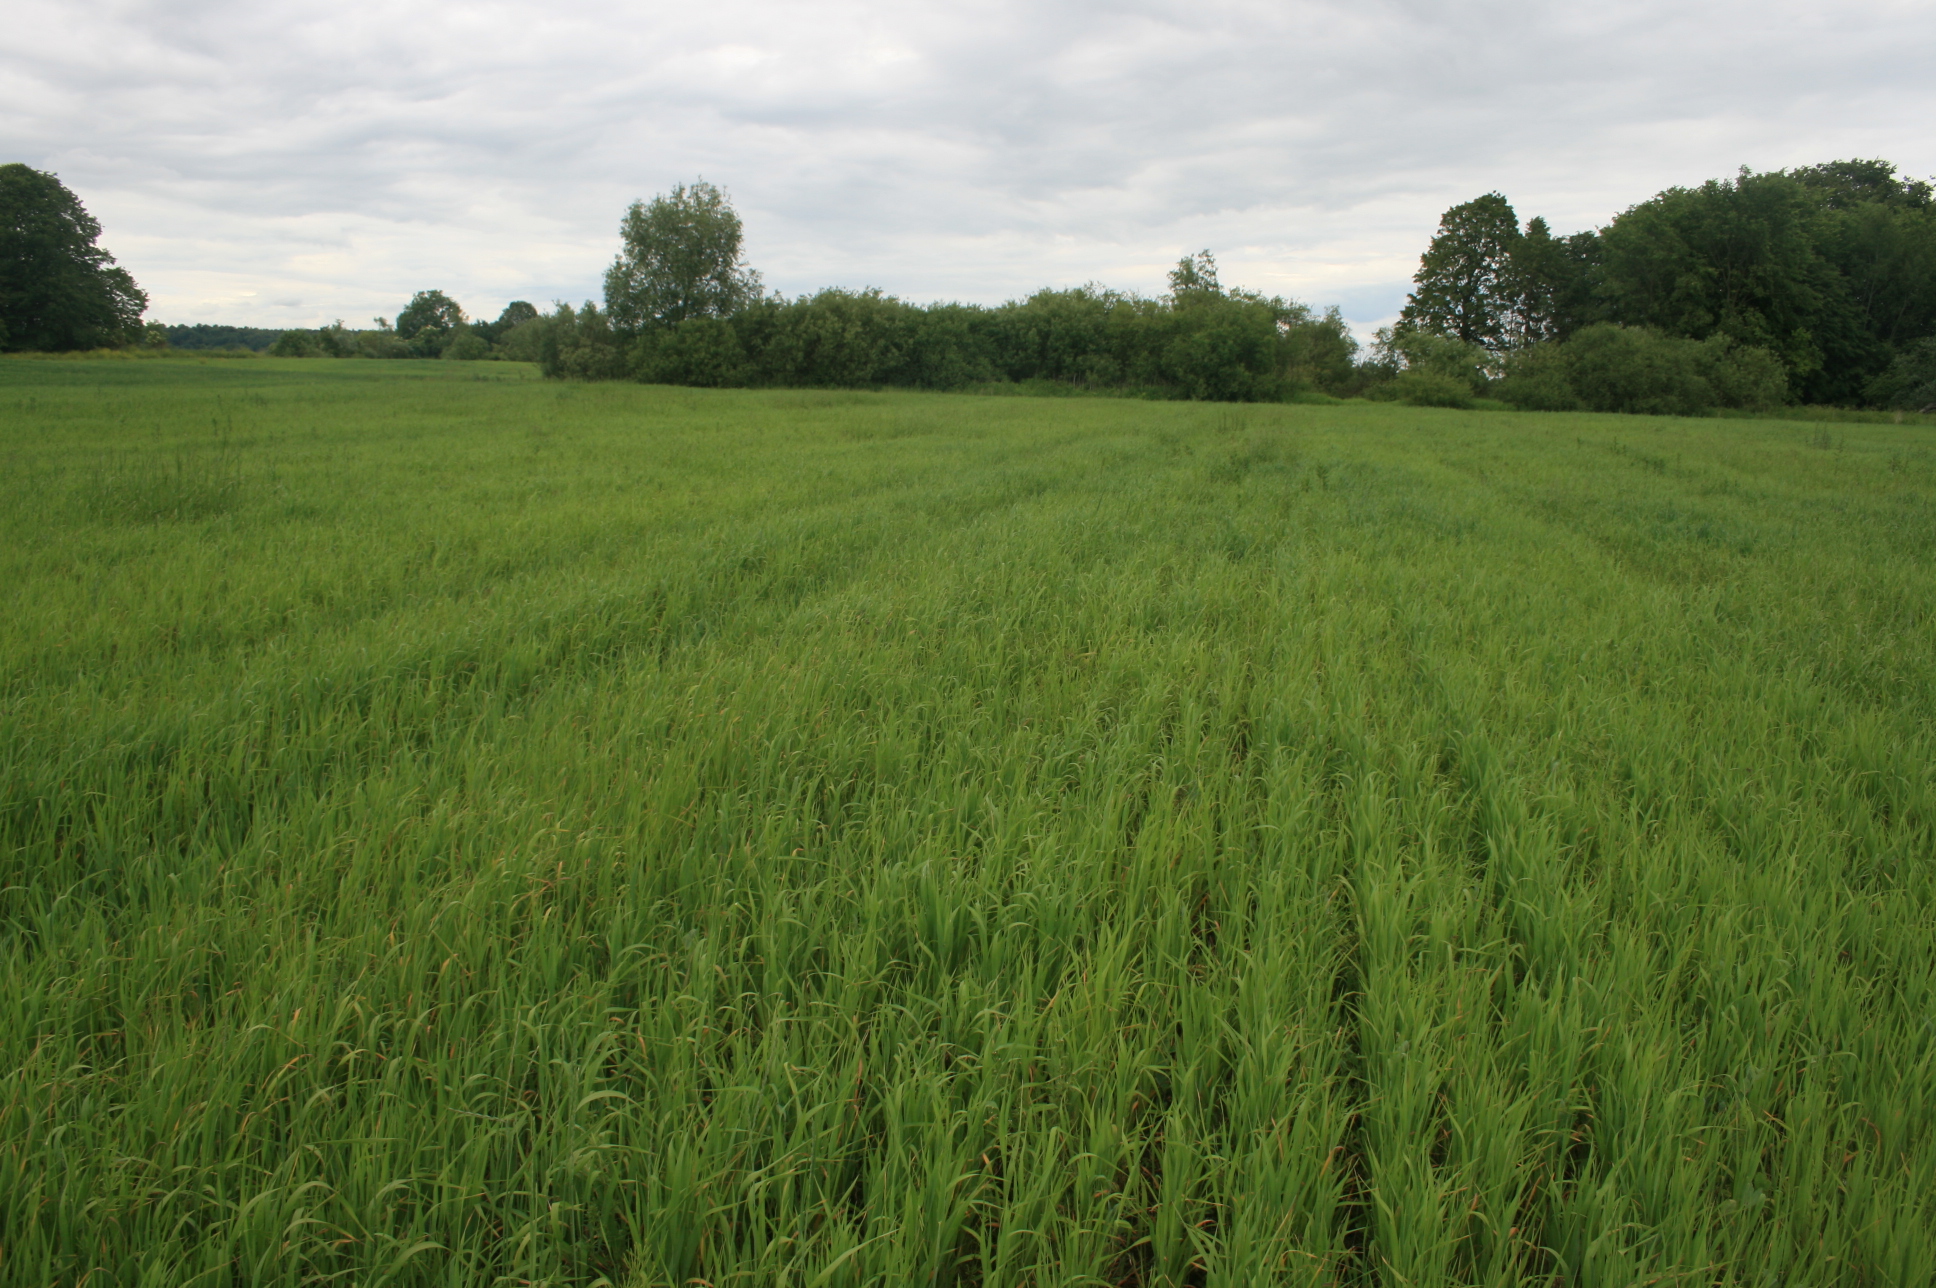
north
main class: Cropland
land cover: Mixed cereals for fodder
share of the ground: > 75 %
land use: Agriculture (excluding fallow land and kitchen gardens)
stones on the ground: < 10 %
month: June
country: LT
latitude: 55.0994
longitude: 21.9484
